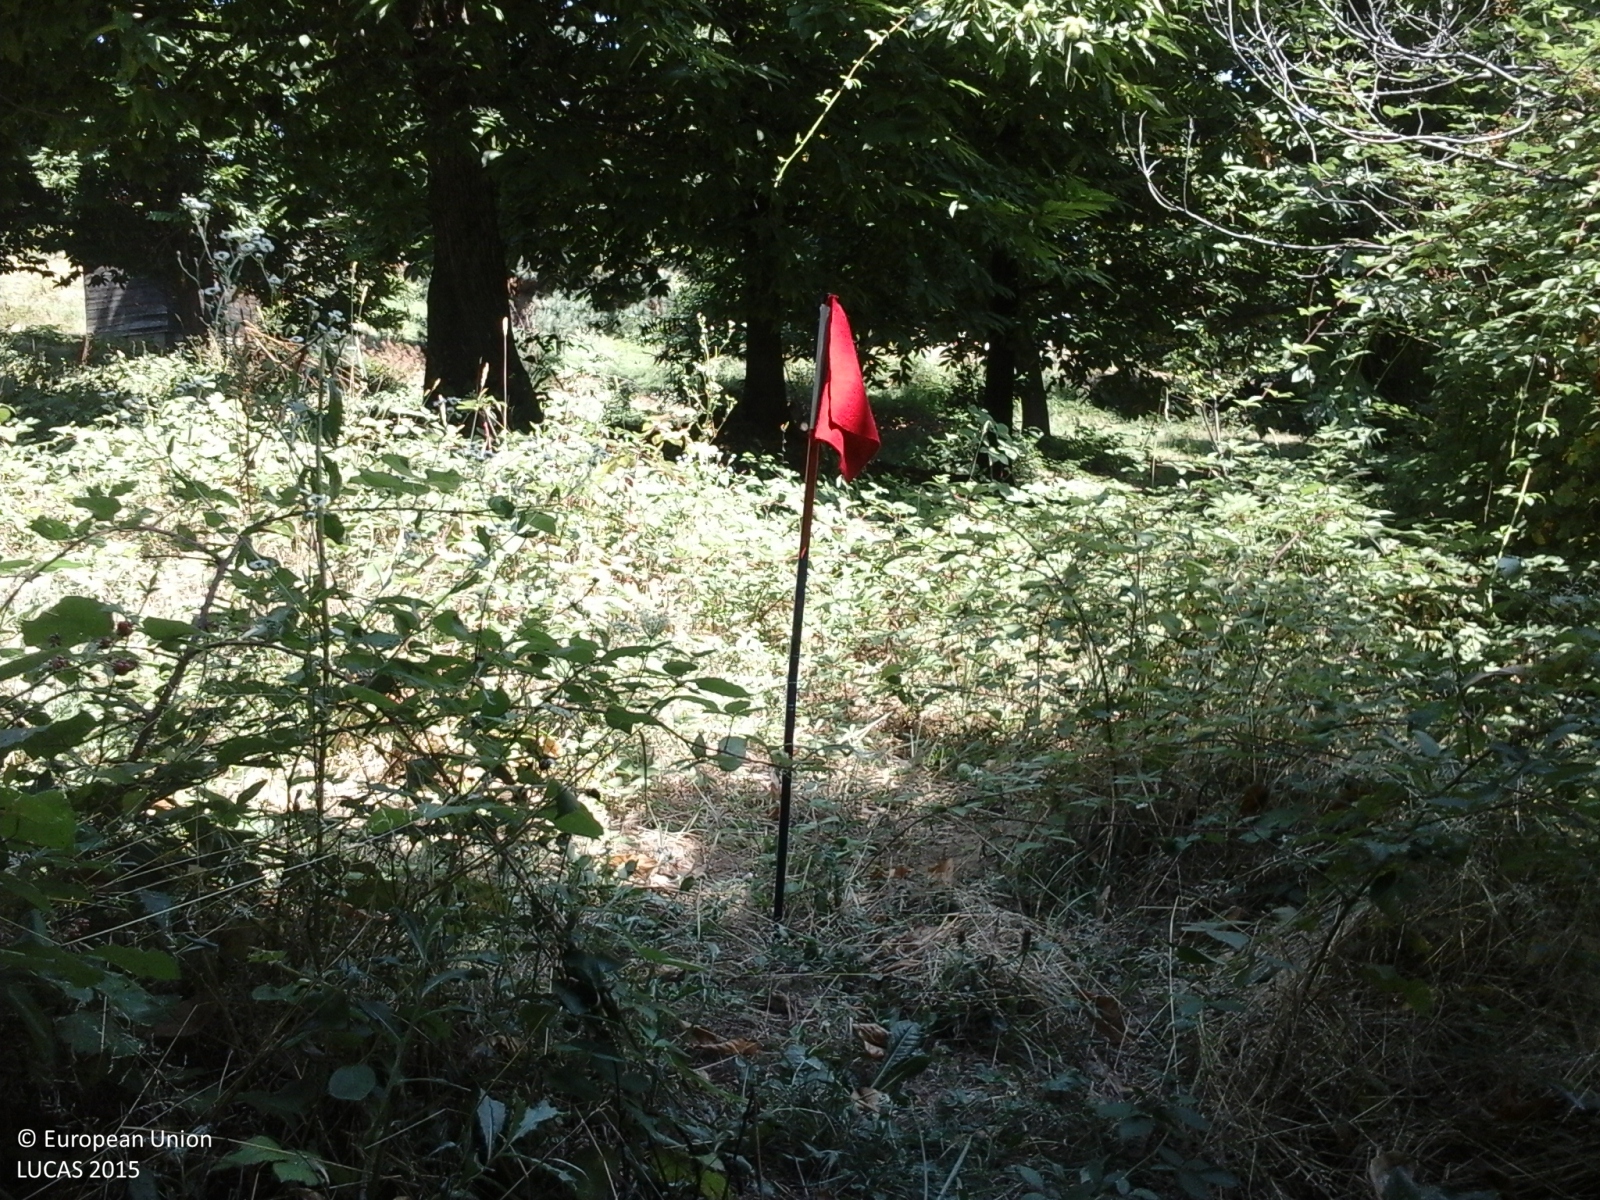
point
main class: Woodland
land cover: Broadleaved woodland
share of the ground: > 75 %
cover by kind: broadleaved forest trees 70 %, herbaceous plants 30 %
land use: Agriculture (excluding fallow land and kitchen gardens)
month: August
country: IT
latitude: 44.3275
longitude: 7.8103
